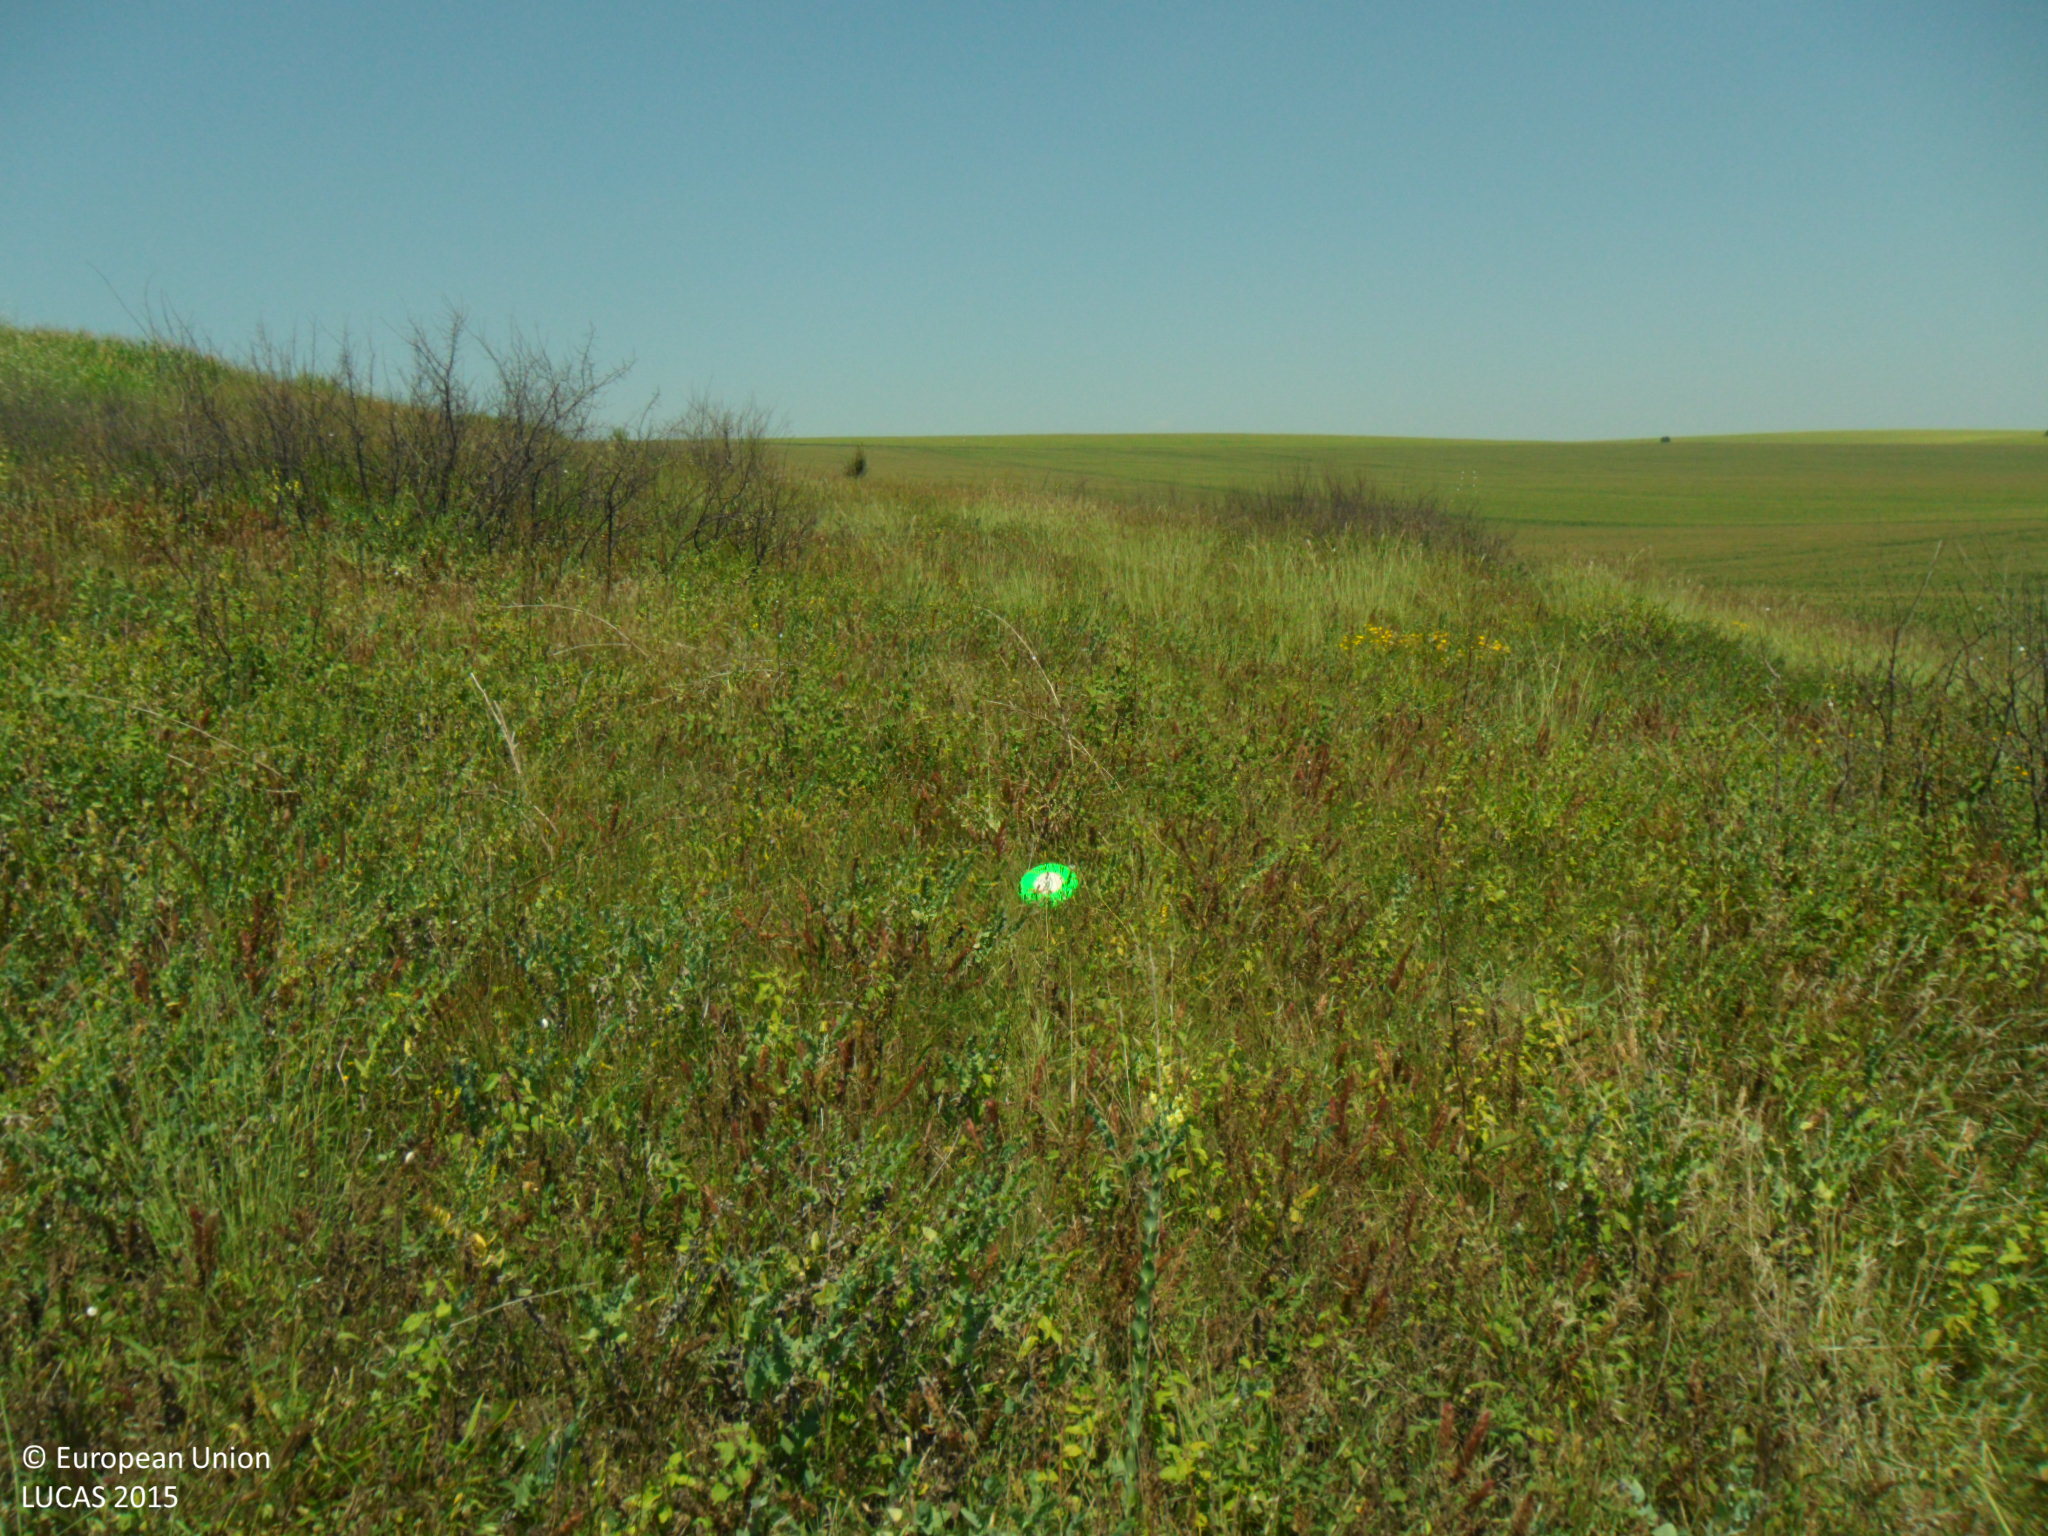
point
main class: Grassland
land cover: Grassland without tree/shrub cover
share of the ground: > 75 %
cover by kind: herbaceous plants 100 %
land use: Agriculture (excluding fallow land and kitchen gardens)
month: July
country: BG
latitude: 43.9174
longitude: 26.5111
